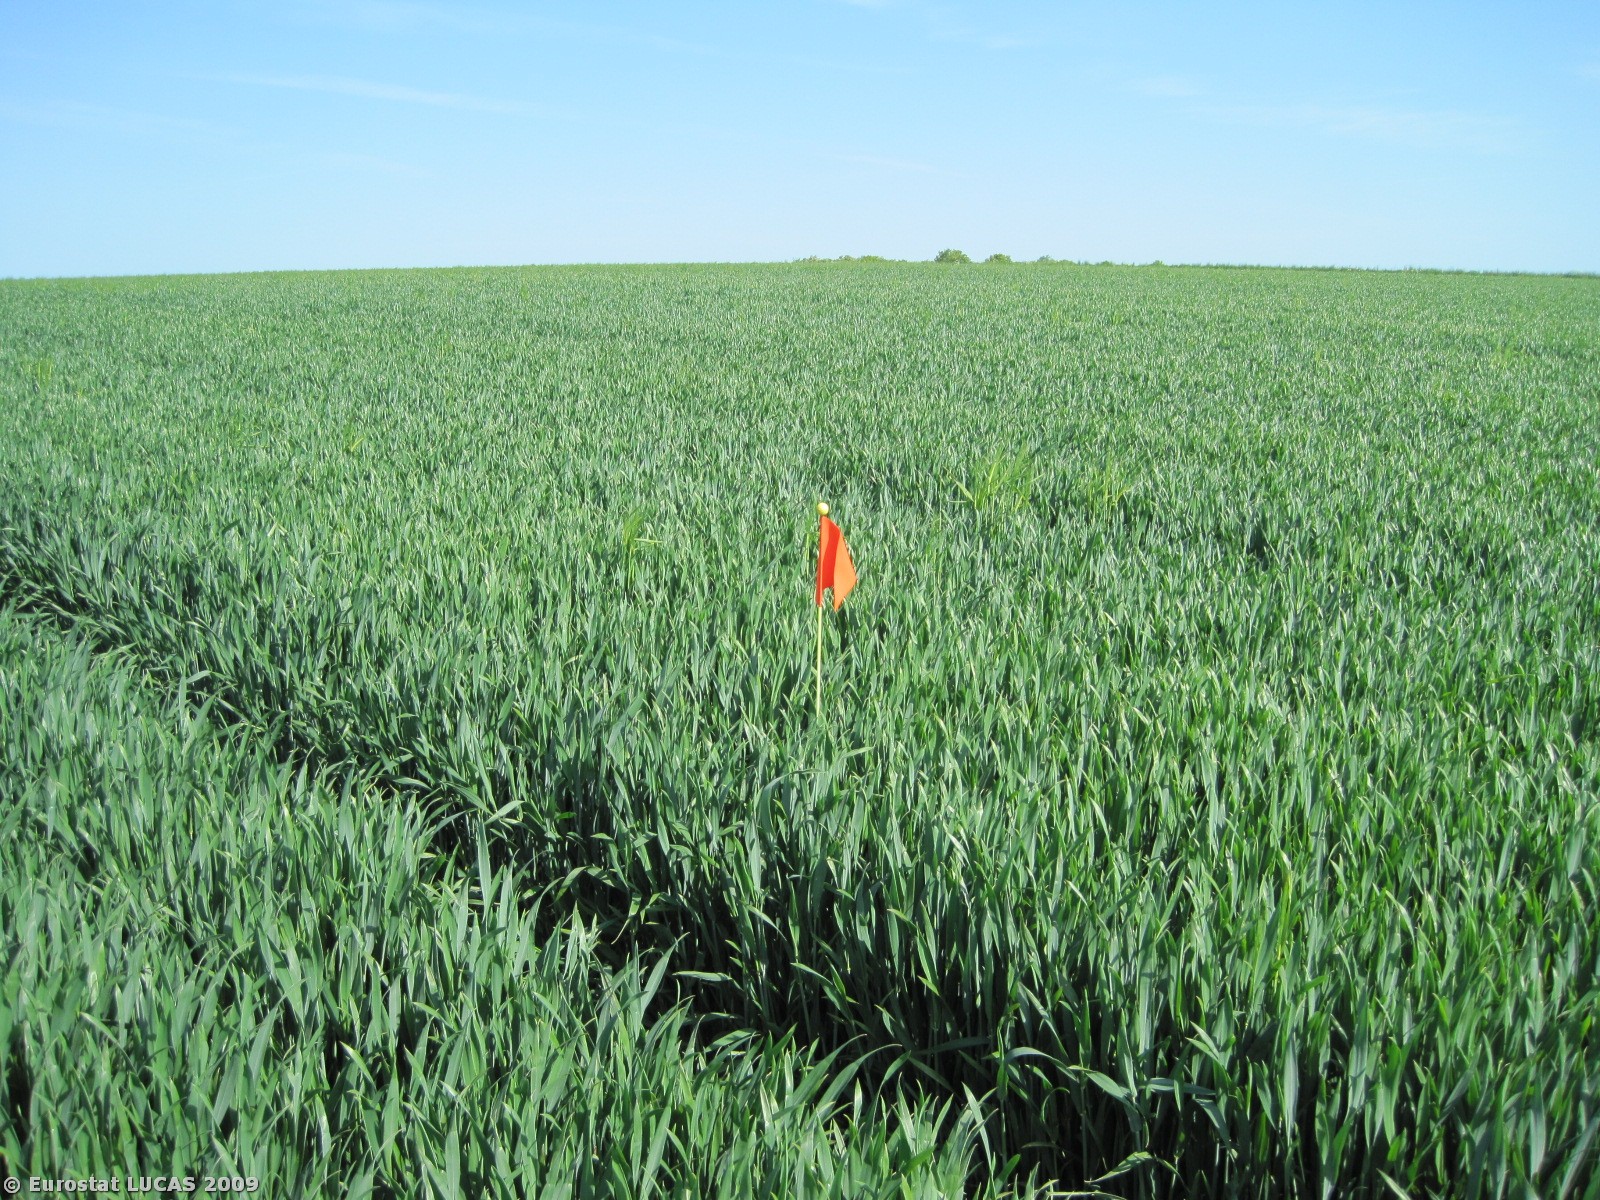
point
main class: Cropland
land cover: Common wheat
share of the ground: > 75 %
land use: Agriculture (excluding fallow land and kitchen gardens)
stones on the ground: < 10 %
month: May
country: DK
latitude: 56.4932
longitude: 10.1460
